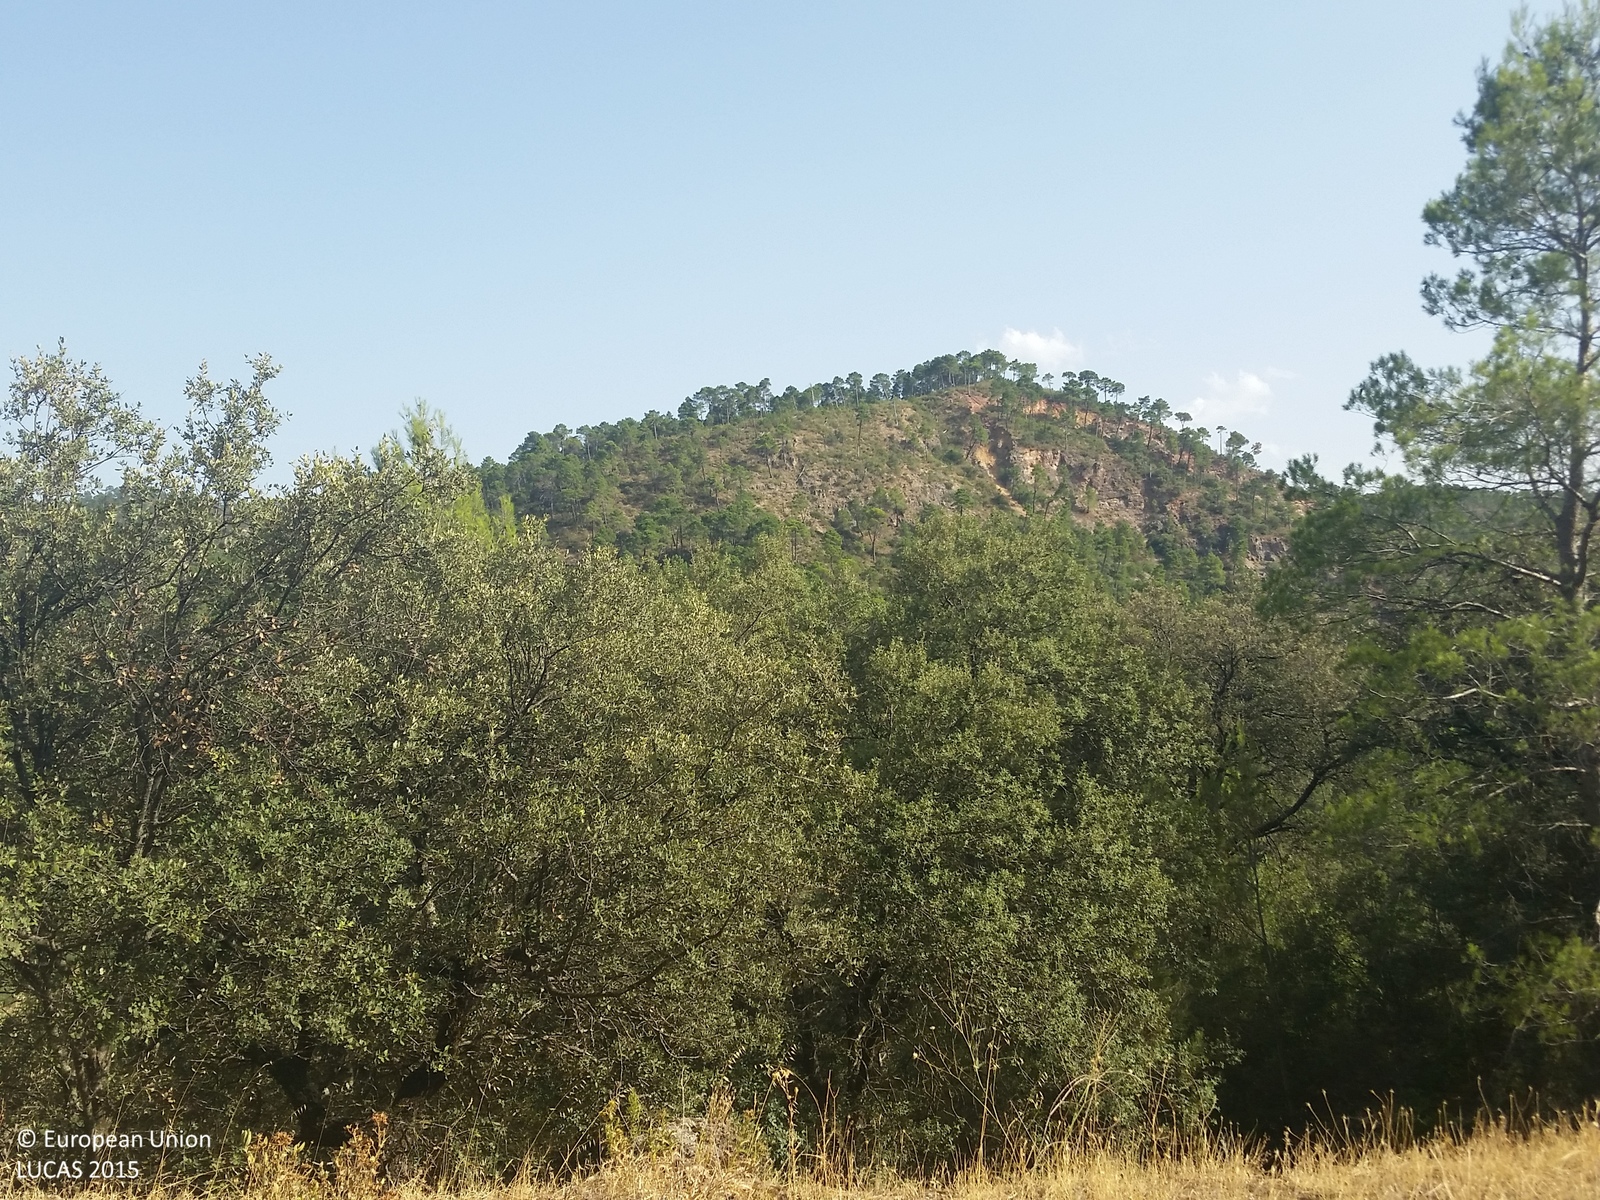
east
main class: Woodland
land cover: Pine dominated coniferous woodland
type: coniferous forest of the mediterranean region
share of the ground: > 75 %
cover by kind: coniferous forest trees 90 %, shrubs 10 %
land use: Semi-natural and natural areas not in use
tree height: > 5 m
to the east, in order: Pine dominated coniferous woodland; Tracks; Pine dominated coniferous woodland
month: August
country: ES
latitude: 38.4640
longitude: -2.5946
